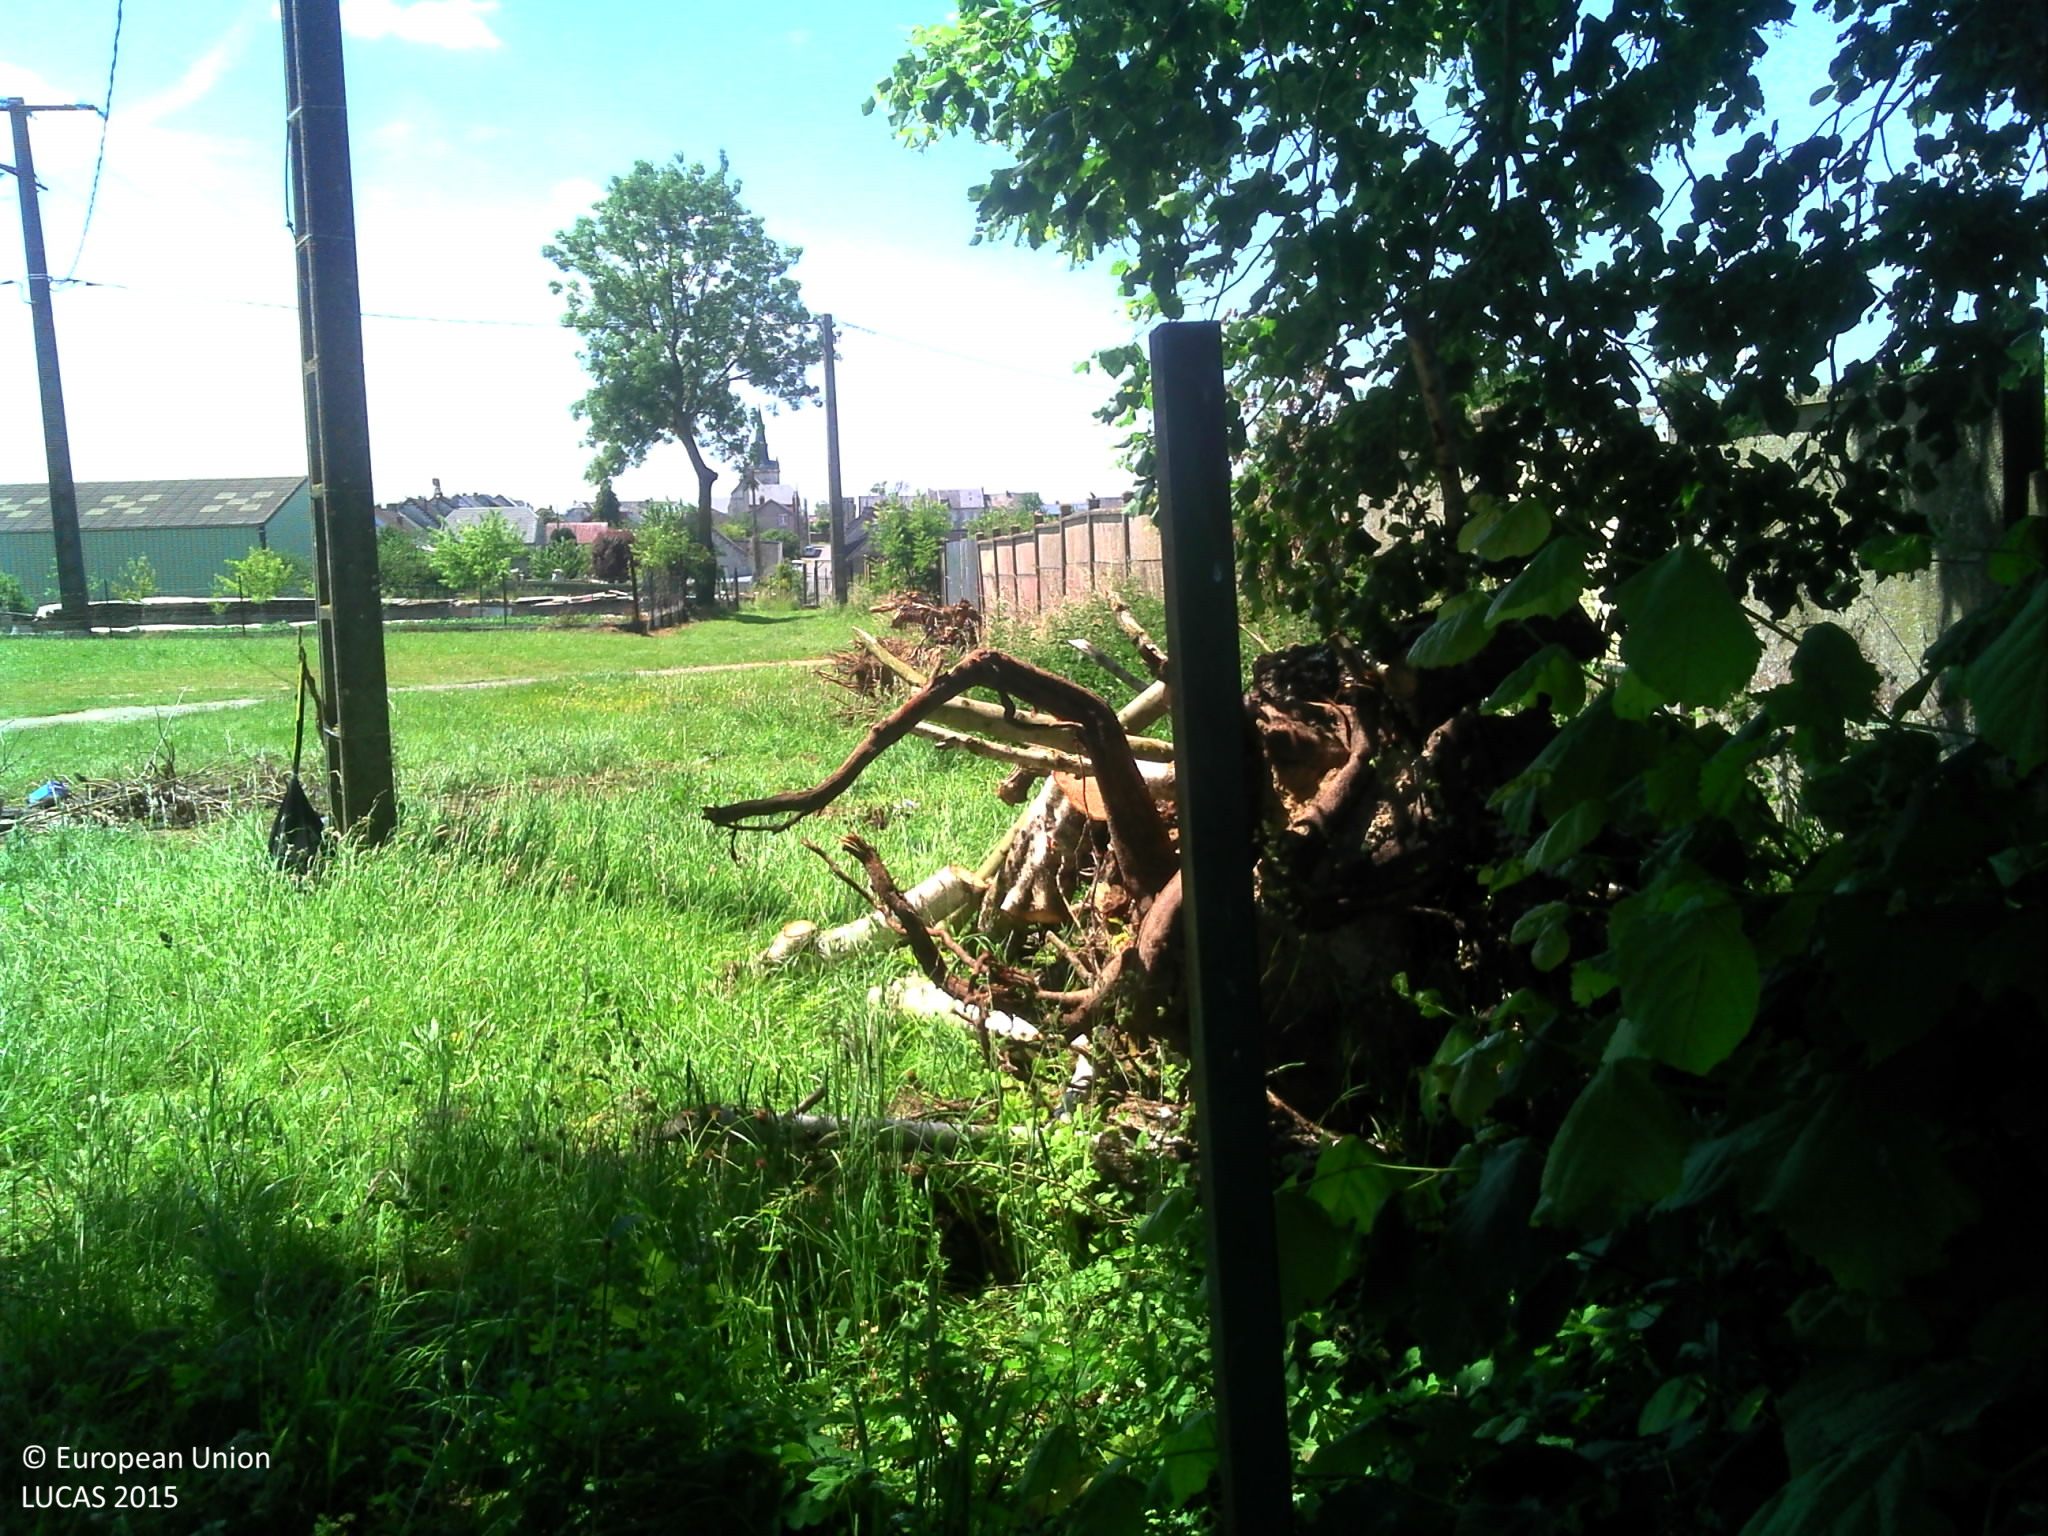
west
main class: Woodland
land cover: Broadleaved woodland
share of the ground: > 75 %
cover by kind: broadleaved forest trees 100 %
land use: Semi-natural and natural areas not in use
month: June
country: FR
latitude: 49.6310
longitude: 4.0275
